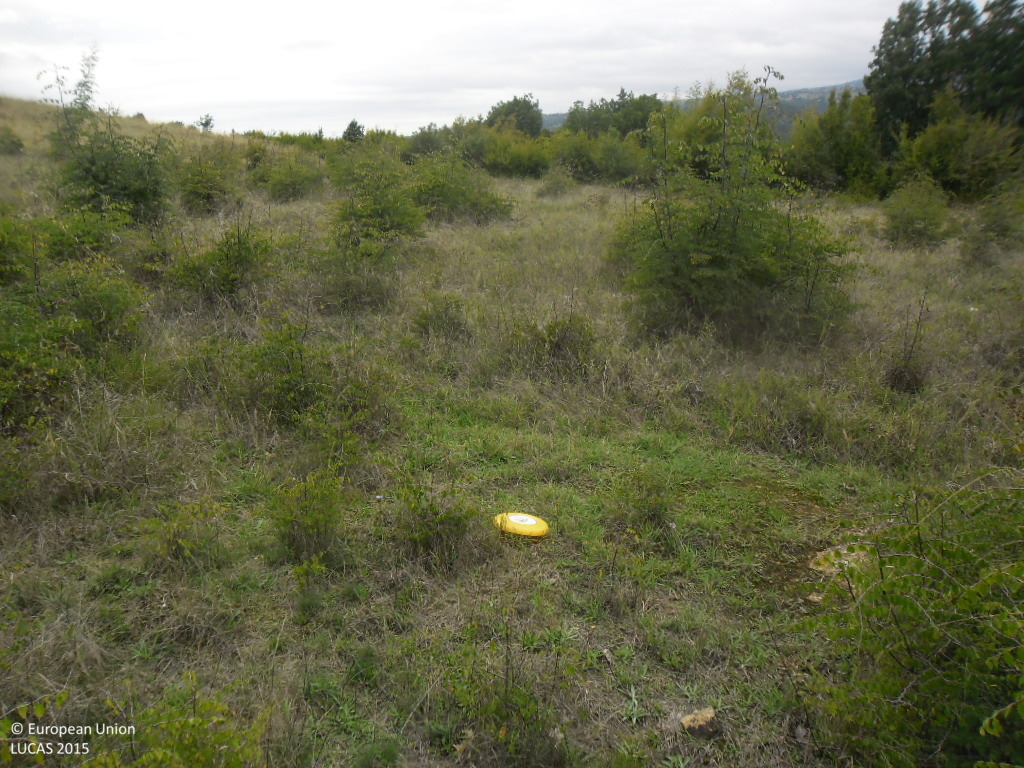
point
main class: Grassland
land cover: Grassland with sparse tree/shrub cover
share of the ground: > 75 %
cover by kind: herbaceous plants 90 %, broadleaved forest trees 5 %, shrubs 5 %
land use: Agriculture (excluding fallow land and kitchen gardens)
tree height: < 5 m
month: September
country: BG
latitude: 41.3867
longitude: 23.0398
